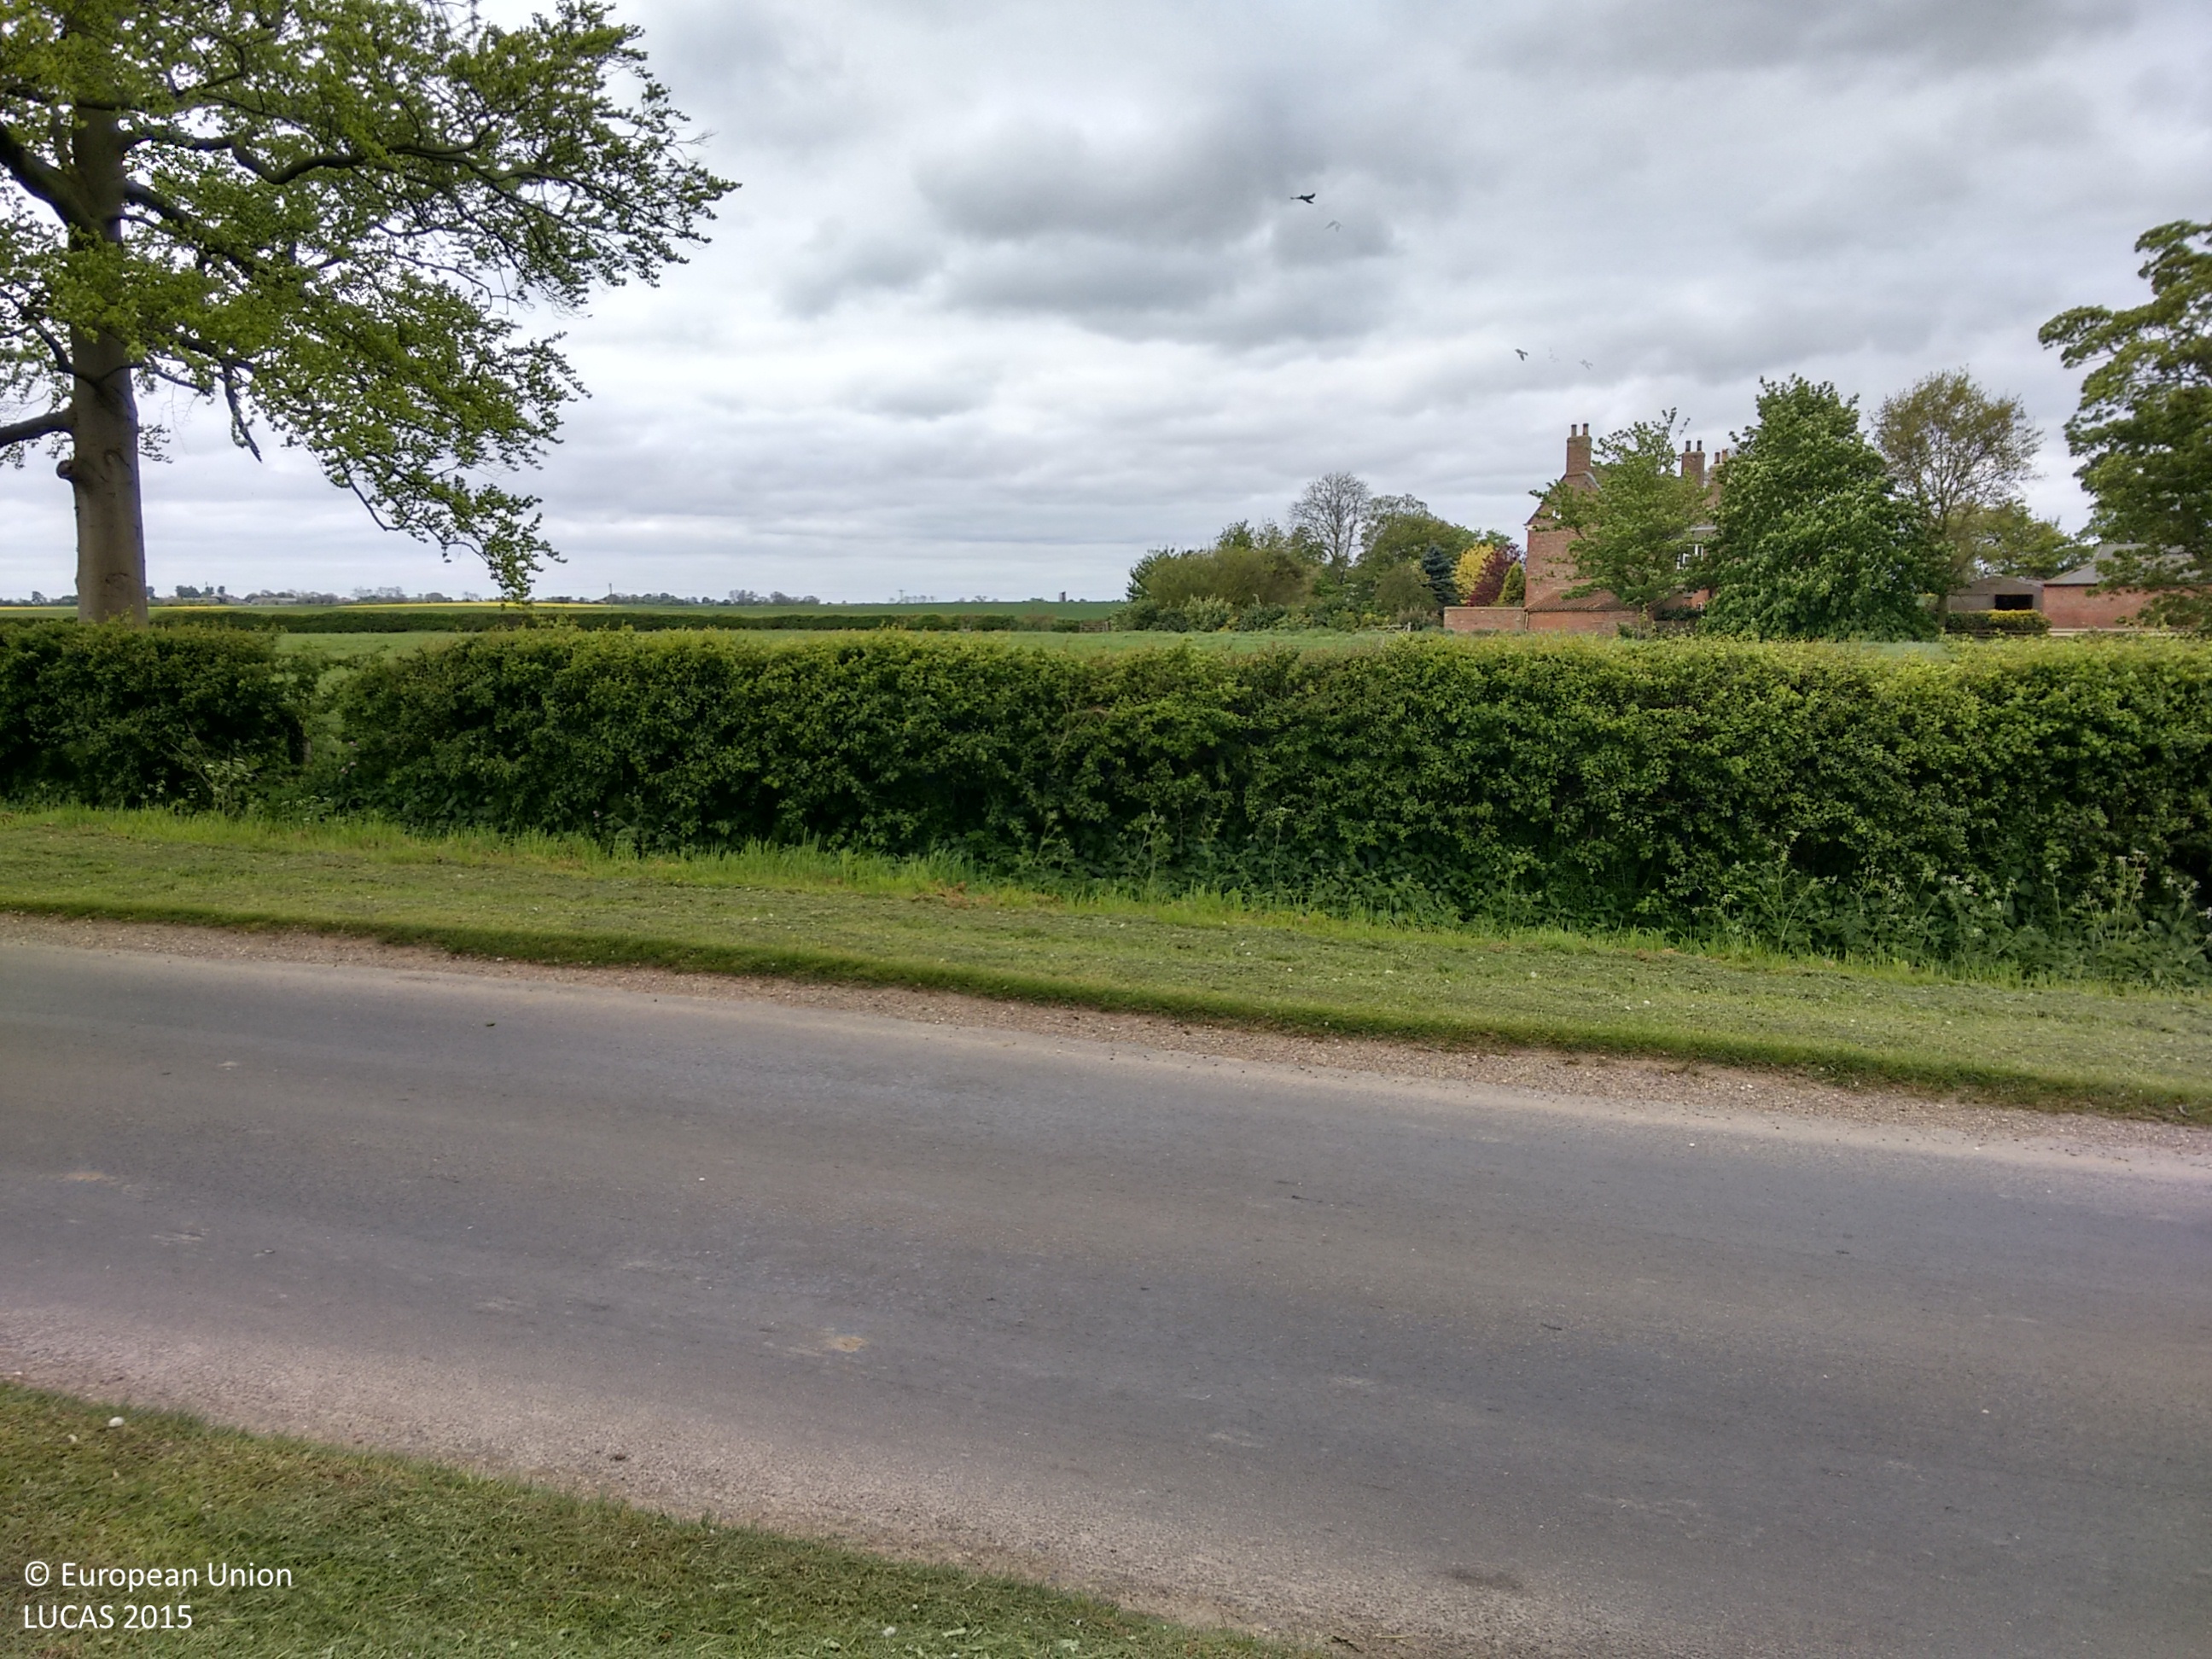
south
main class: Cropland
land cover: Common wheat
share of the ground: > 75 %
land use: Agriculture (excluding fallow land and kitchen gardens)
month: May
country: GB
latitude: 53.7919
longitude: -0.1274
